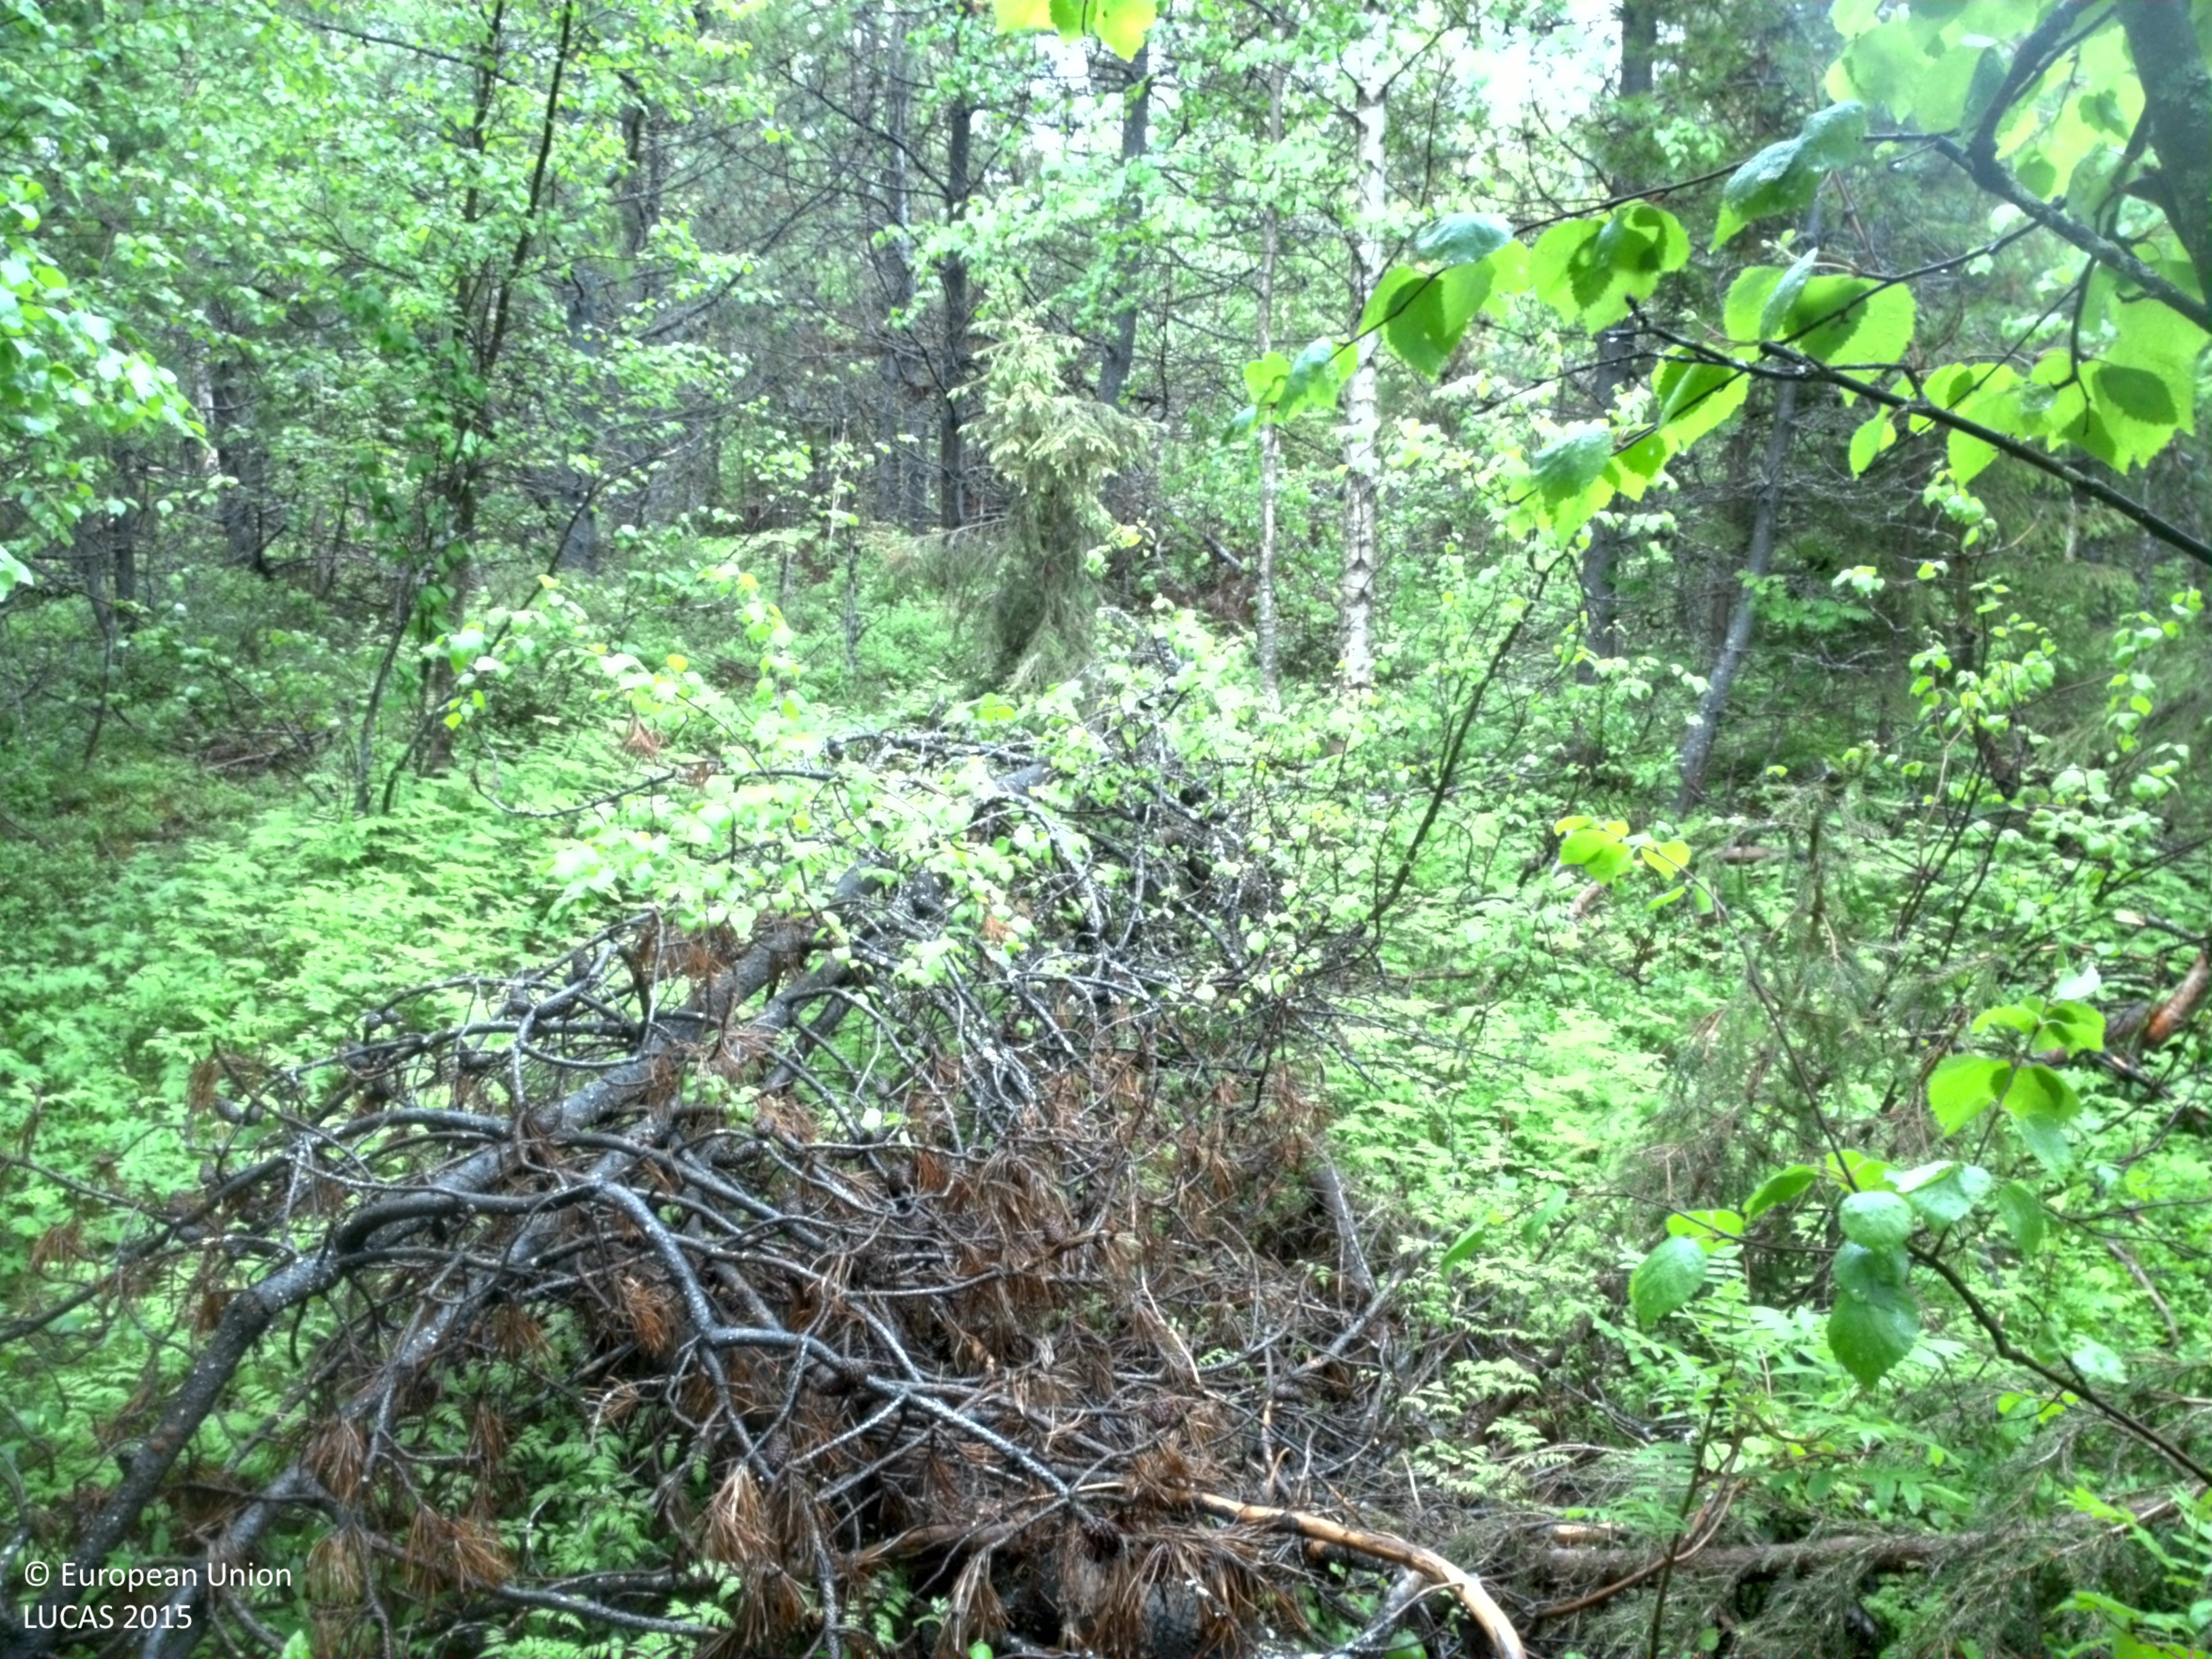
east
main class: Woodland
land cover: Pine dominated mixed woodland
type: exotic forest
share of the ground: > 75 %
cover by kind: coniferous forest trees 40 %, broadleaved forest trees 40 %, shrubs 10 %, herbaceous plants 10 %
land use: Forestry
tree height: > 5 m
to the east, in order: Pine dominated mixed woodland; Spruce dominated mixed woodland; Pine dominated mixed woodland
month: June
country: SE
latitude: 66.5776
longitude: 22.8016
